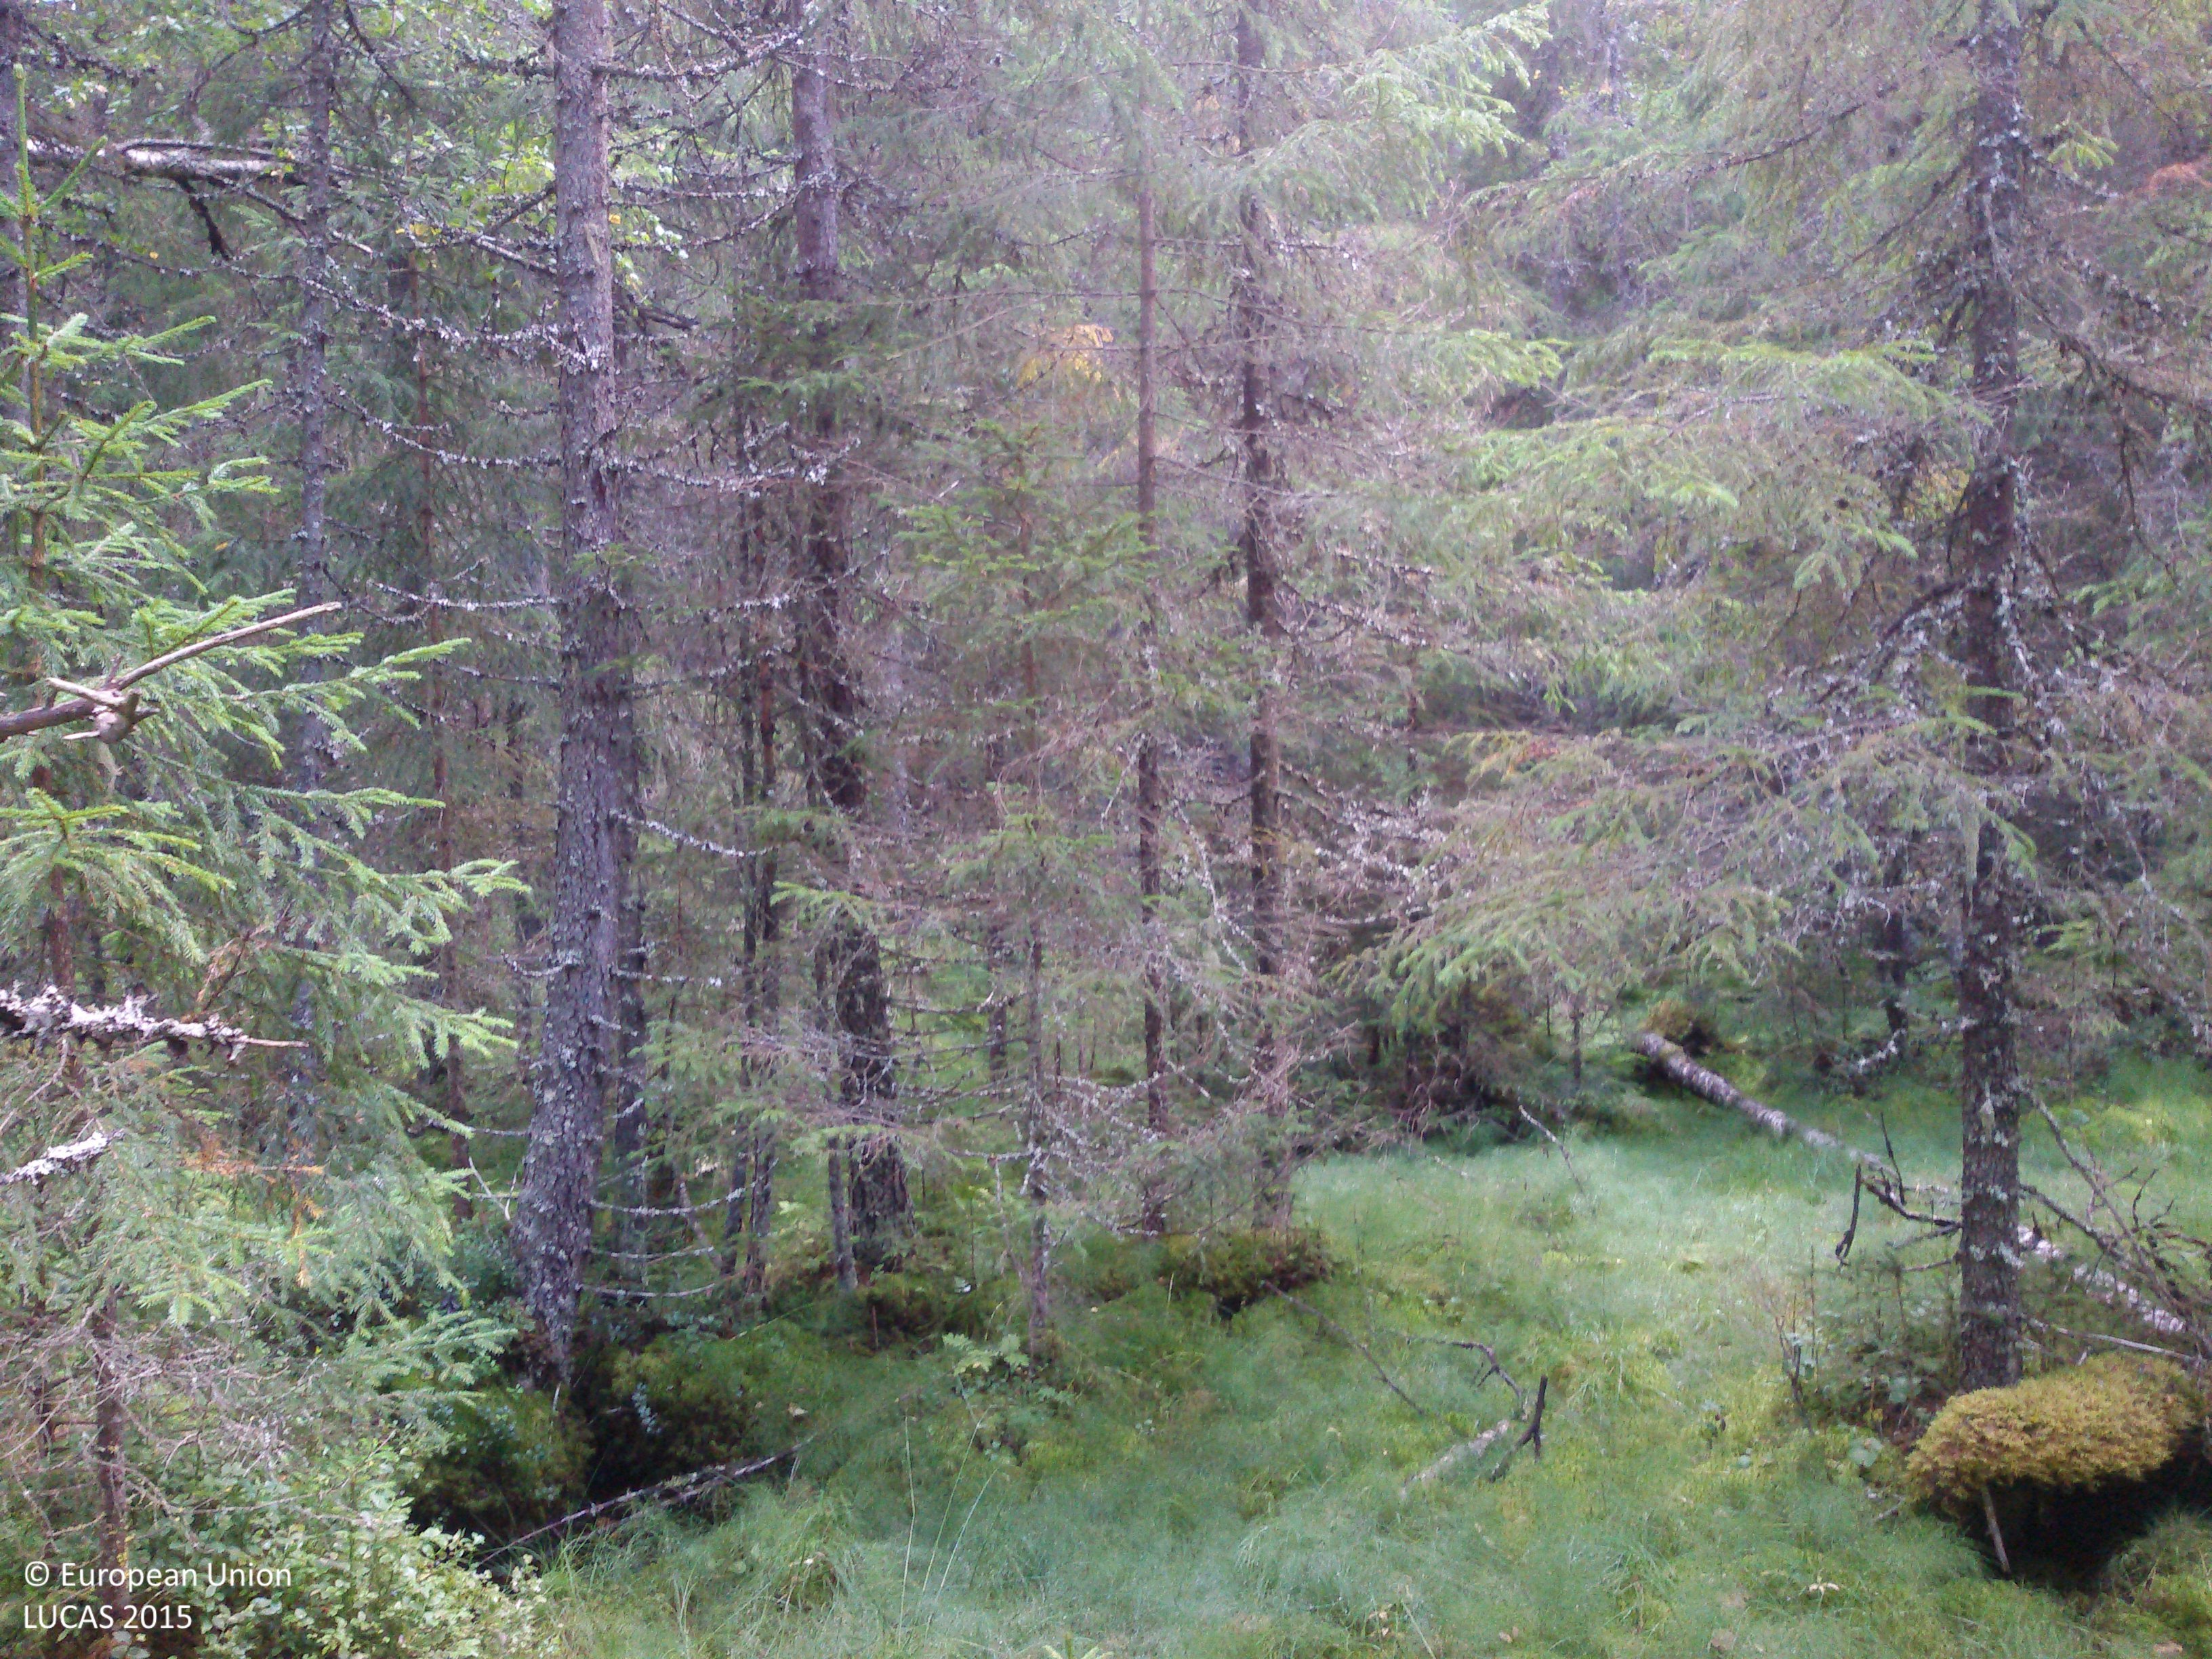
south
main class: Woodland
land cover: Spruce dominated coniferous woodland
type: boreal forest
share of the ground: > 75 %
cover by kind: coniferous forest trees 80 %, herbaceous plants 10 %, lichens and mosses 10 %
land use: Forestry
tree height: > 5 m
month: September
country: SE
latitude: 61.0848
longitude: 15.4920
